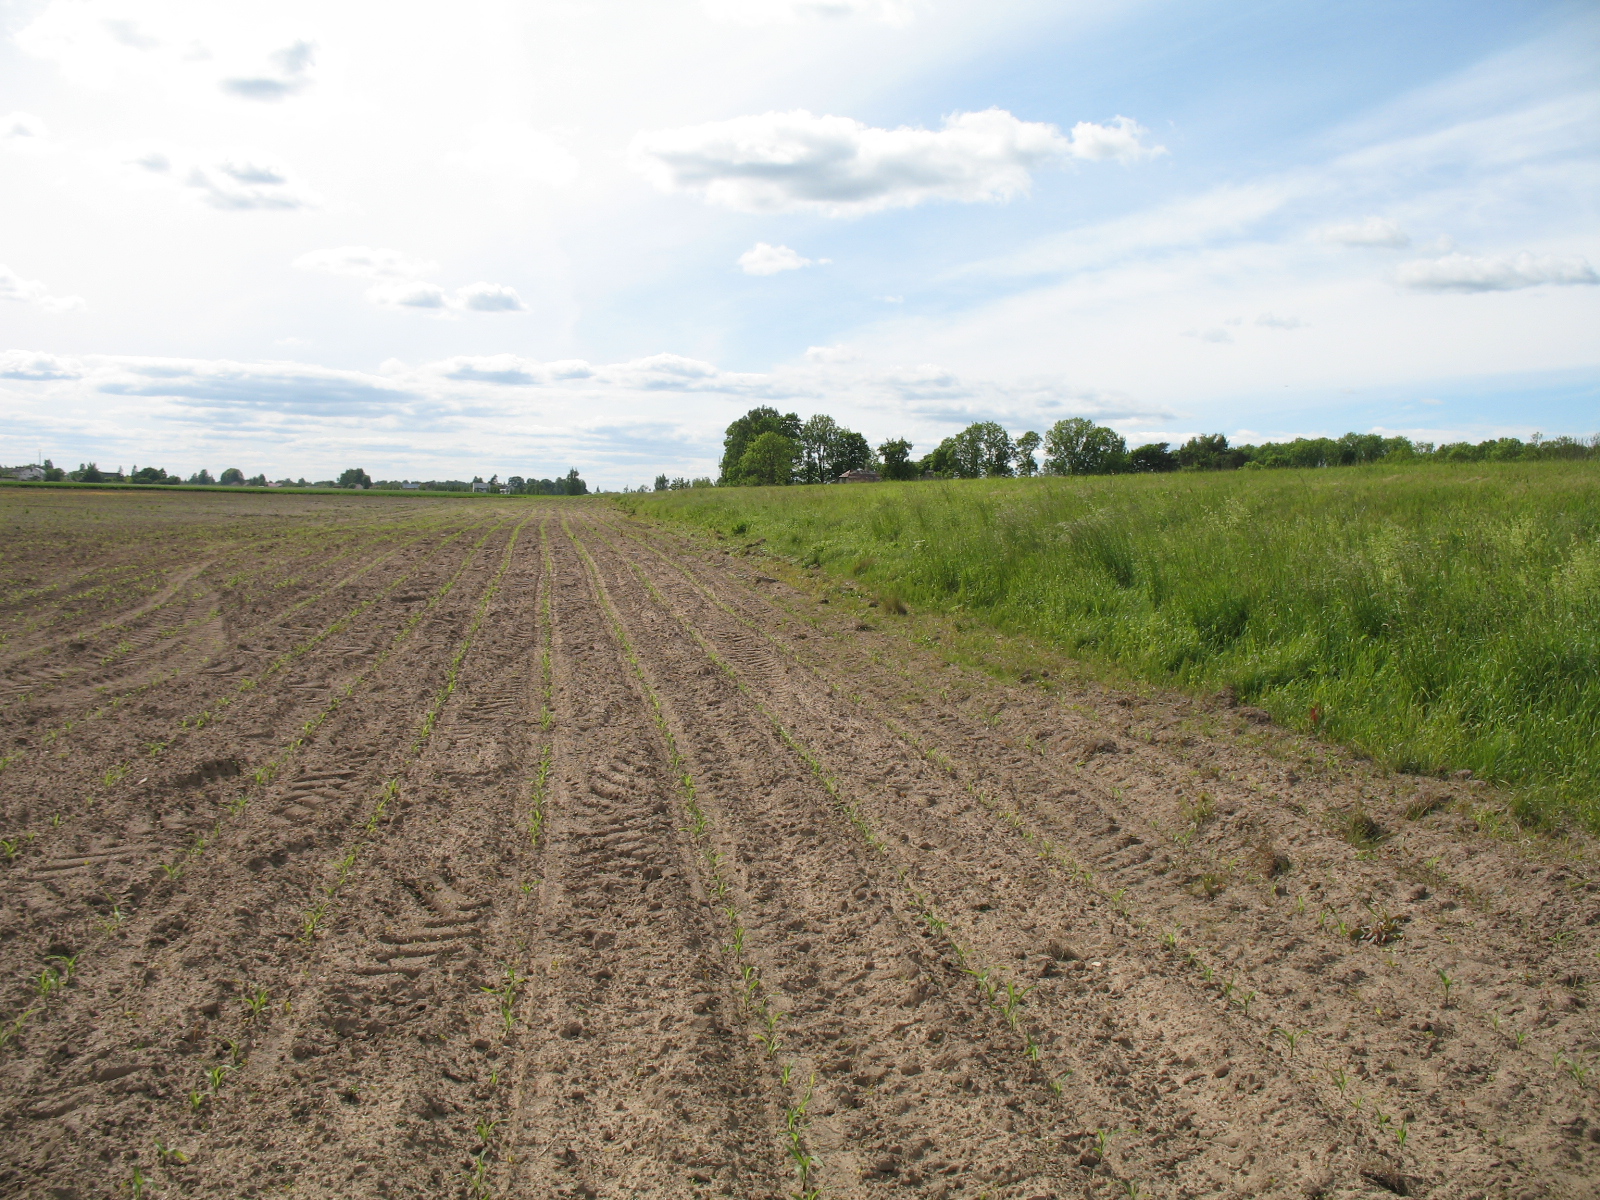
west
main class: Cropland
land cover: Maize
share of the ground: < 10 %
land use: Agriculture (excluding fallow land and kitchen gardens)
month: June
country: LV
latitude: 56.6218
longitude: 23.4873
